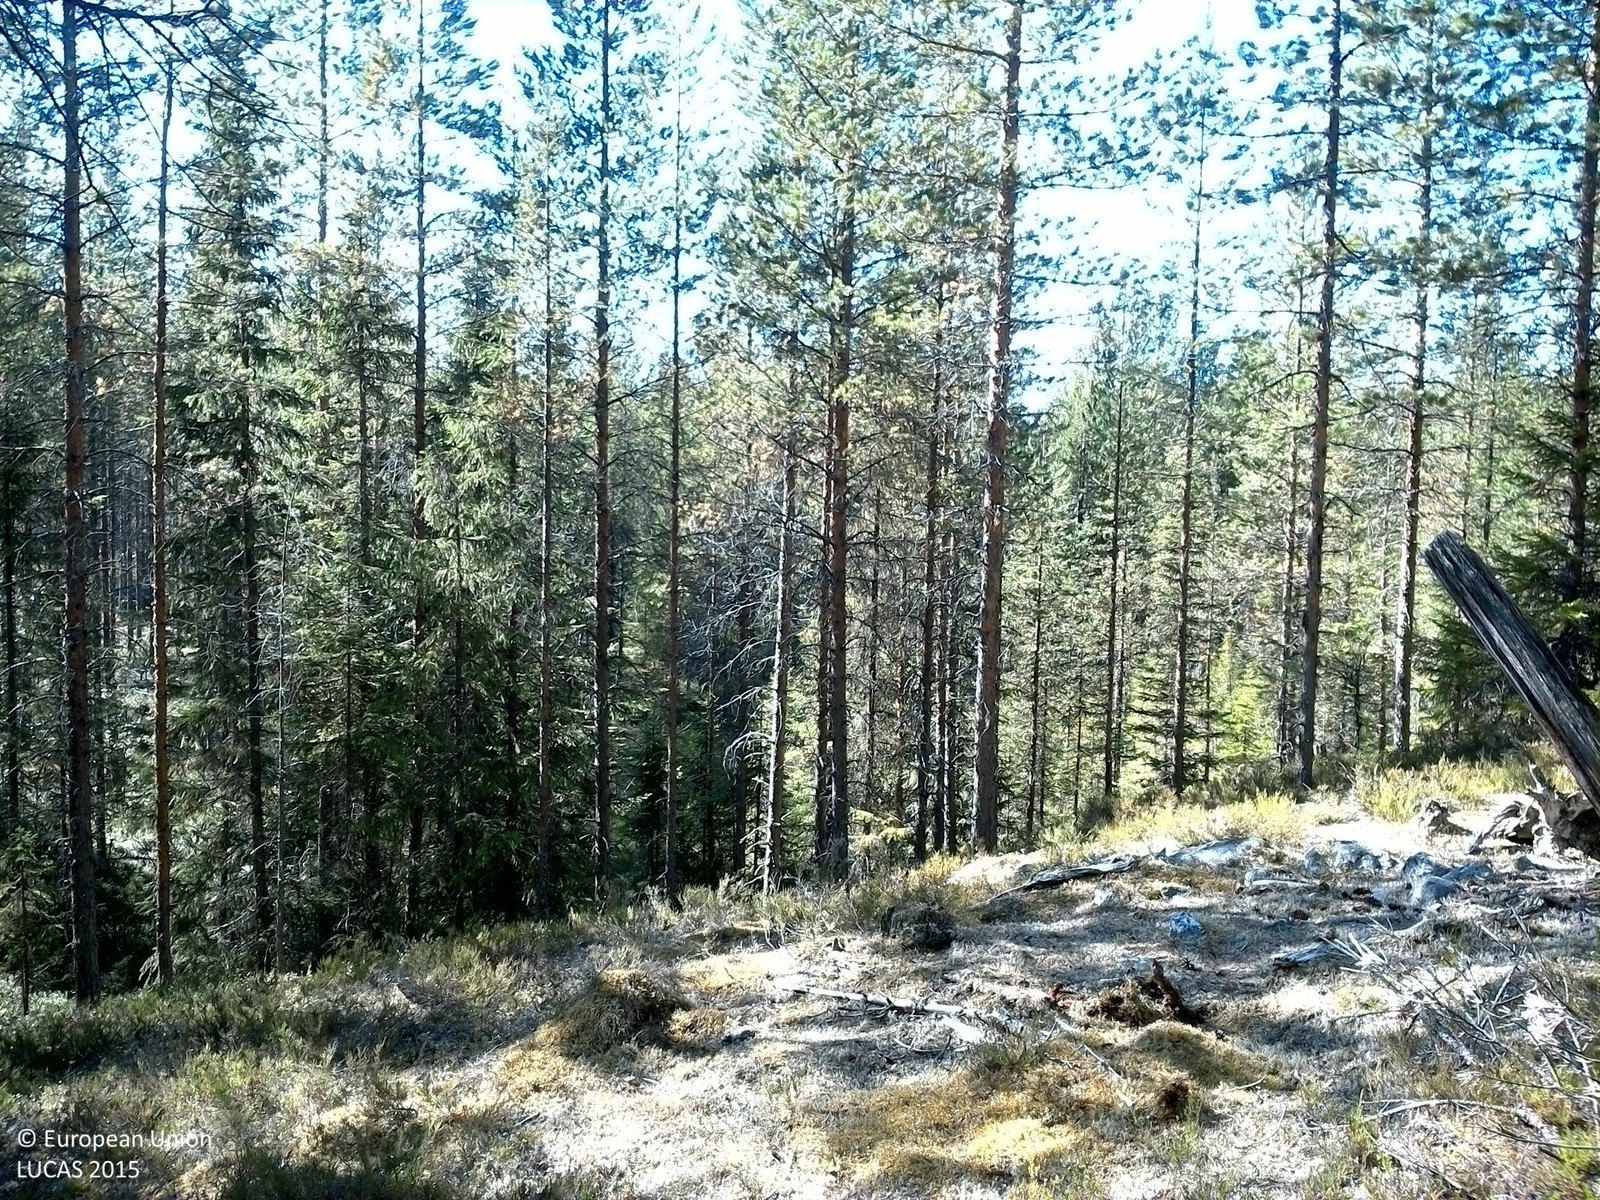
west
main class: Woodland
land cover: Pine dominated coniferous woodland
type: boreal forest
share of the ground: 50 - 75 %
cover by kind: coniferous forest trees 60 %, shrubs 20 %, lichens and mosses 15 %, broadleaved forest trees 5 %
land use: Forestry
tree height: > 5 m
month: August
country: SE
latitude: 63.6438
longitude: 17.4228
